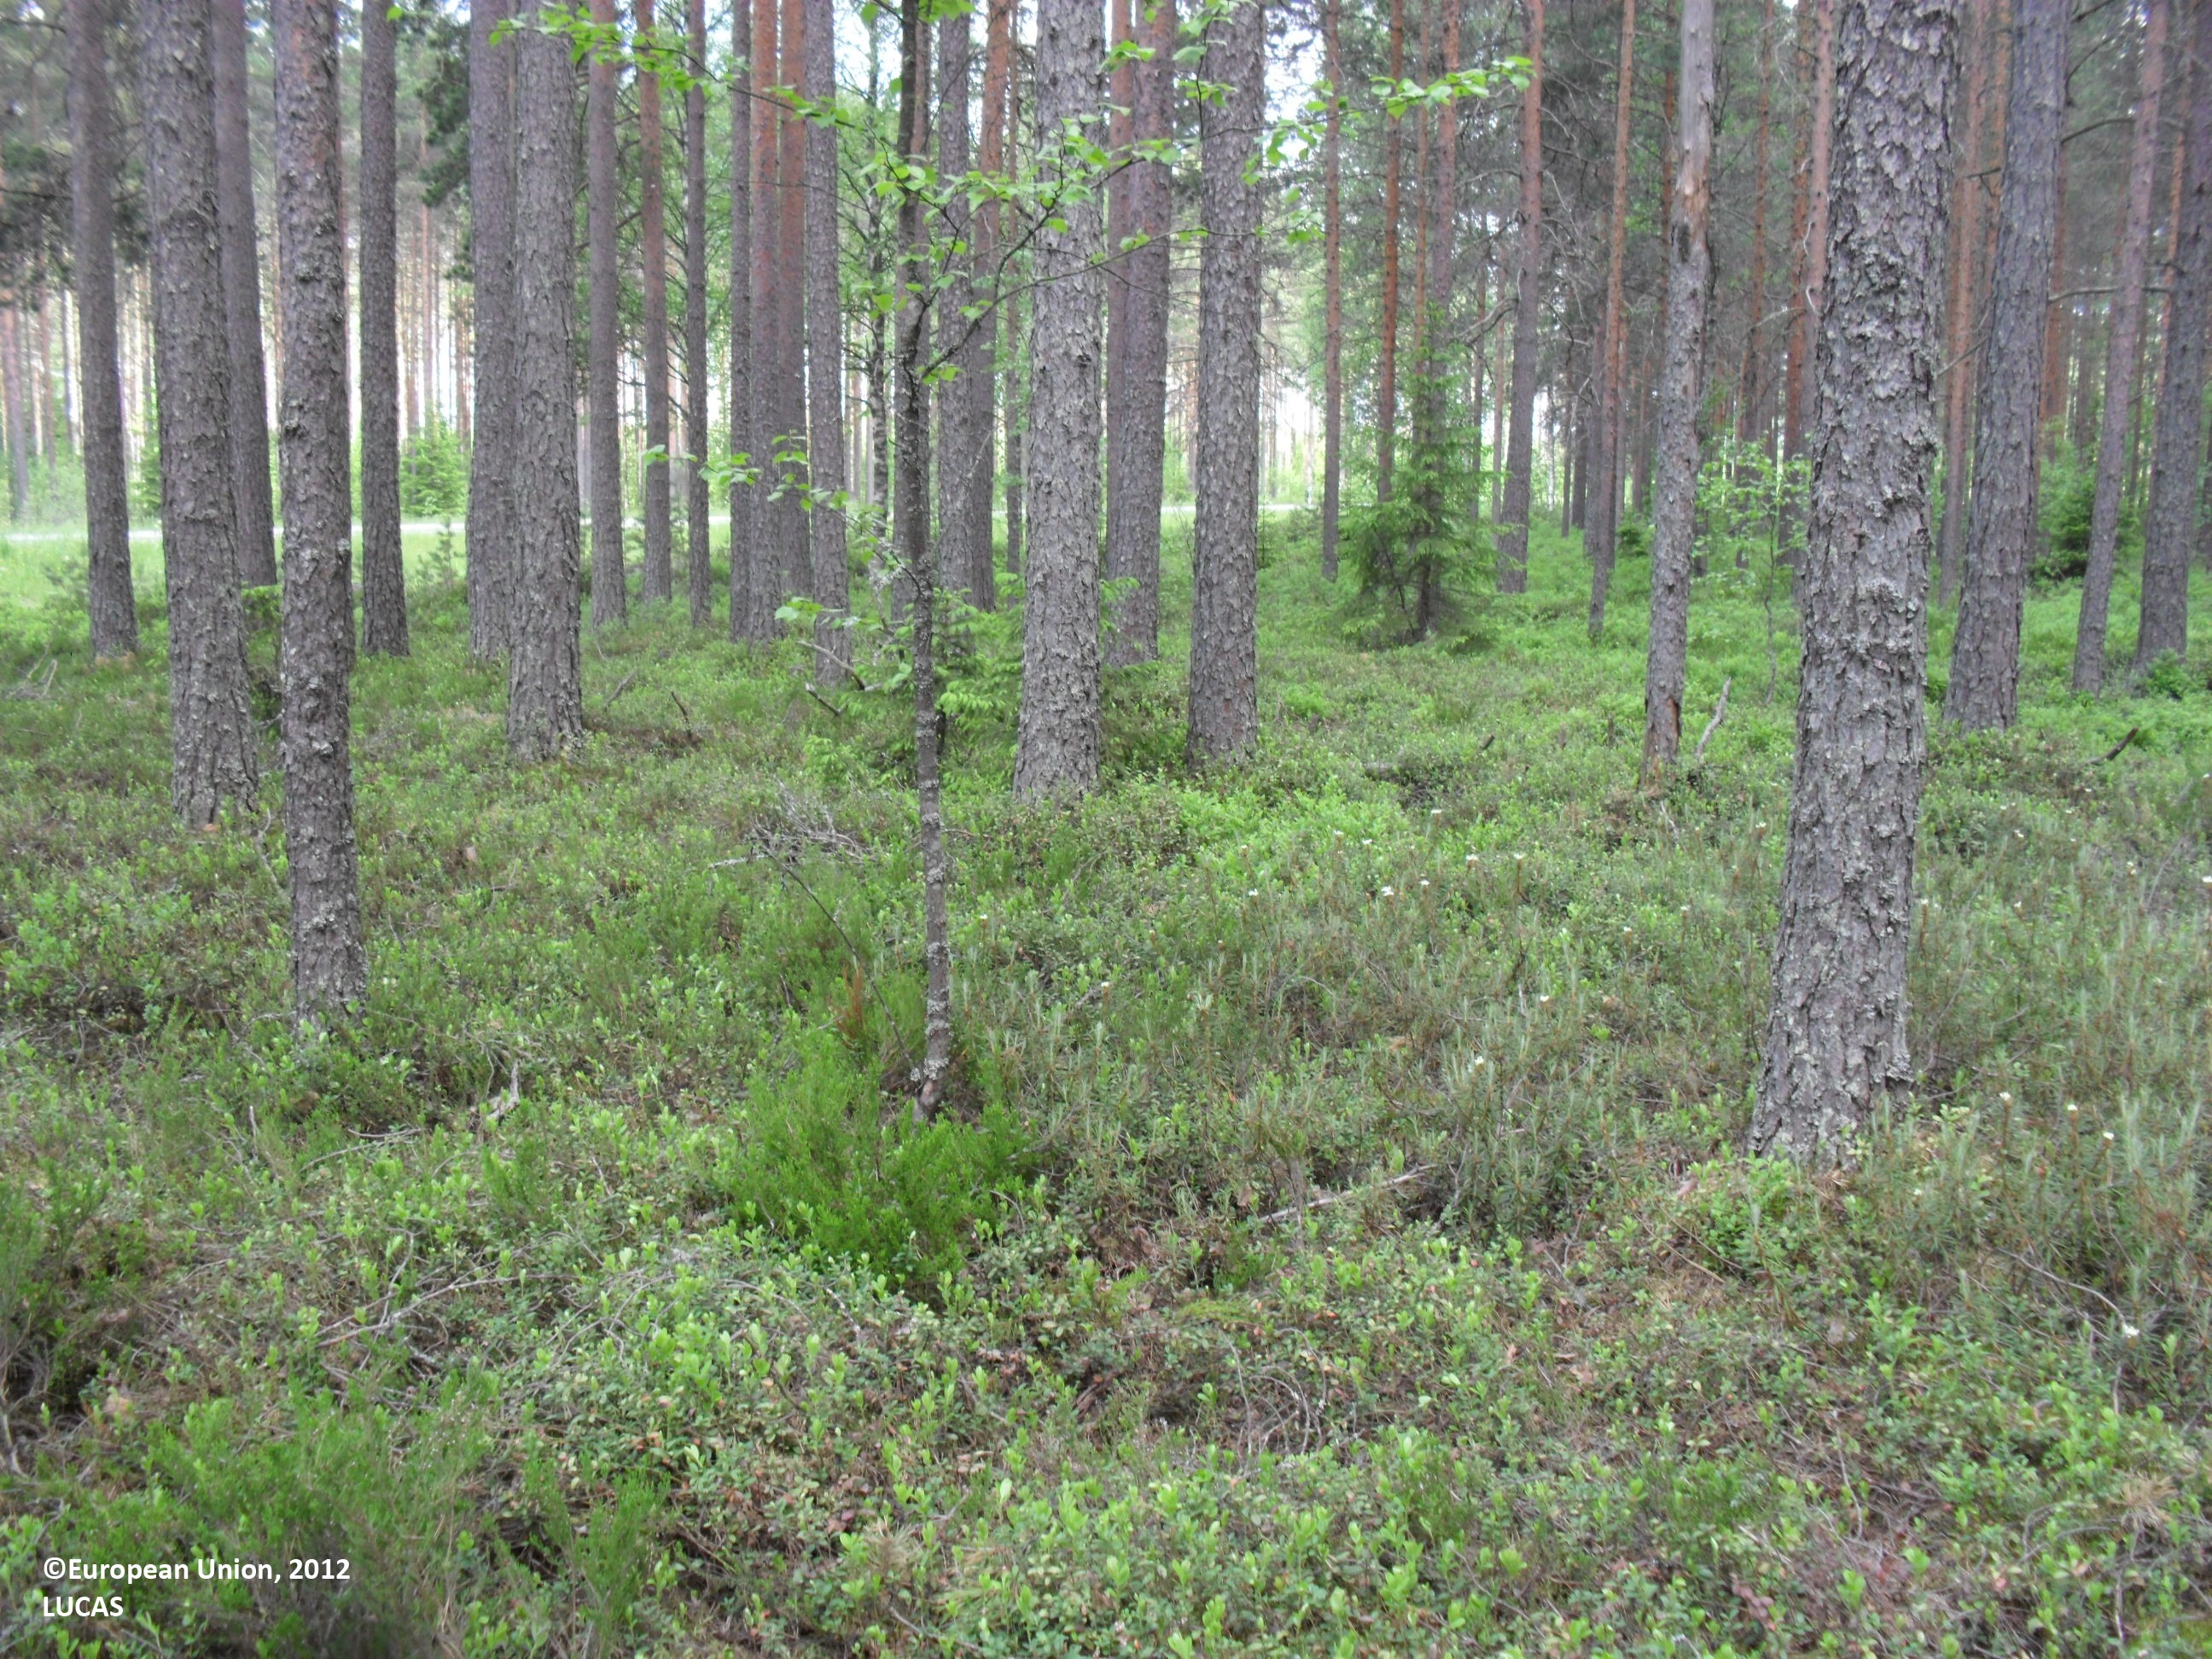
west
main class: Woodland
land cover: Pine dominated coniferous woodland
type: boreal forest
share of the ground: 50 - 75 %
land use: Forestry
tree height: > 5 m
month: June
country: FI
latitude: 62.7650
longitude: 23.3657
